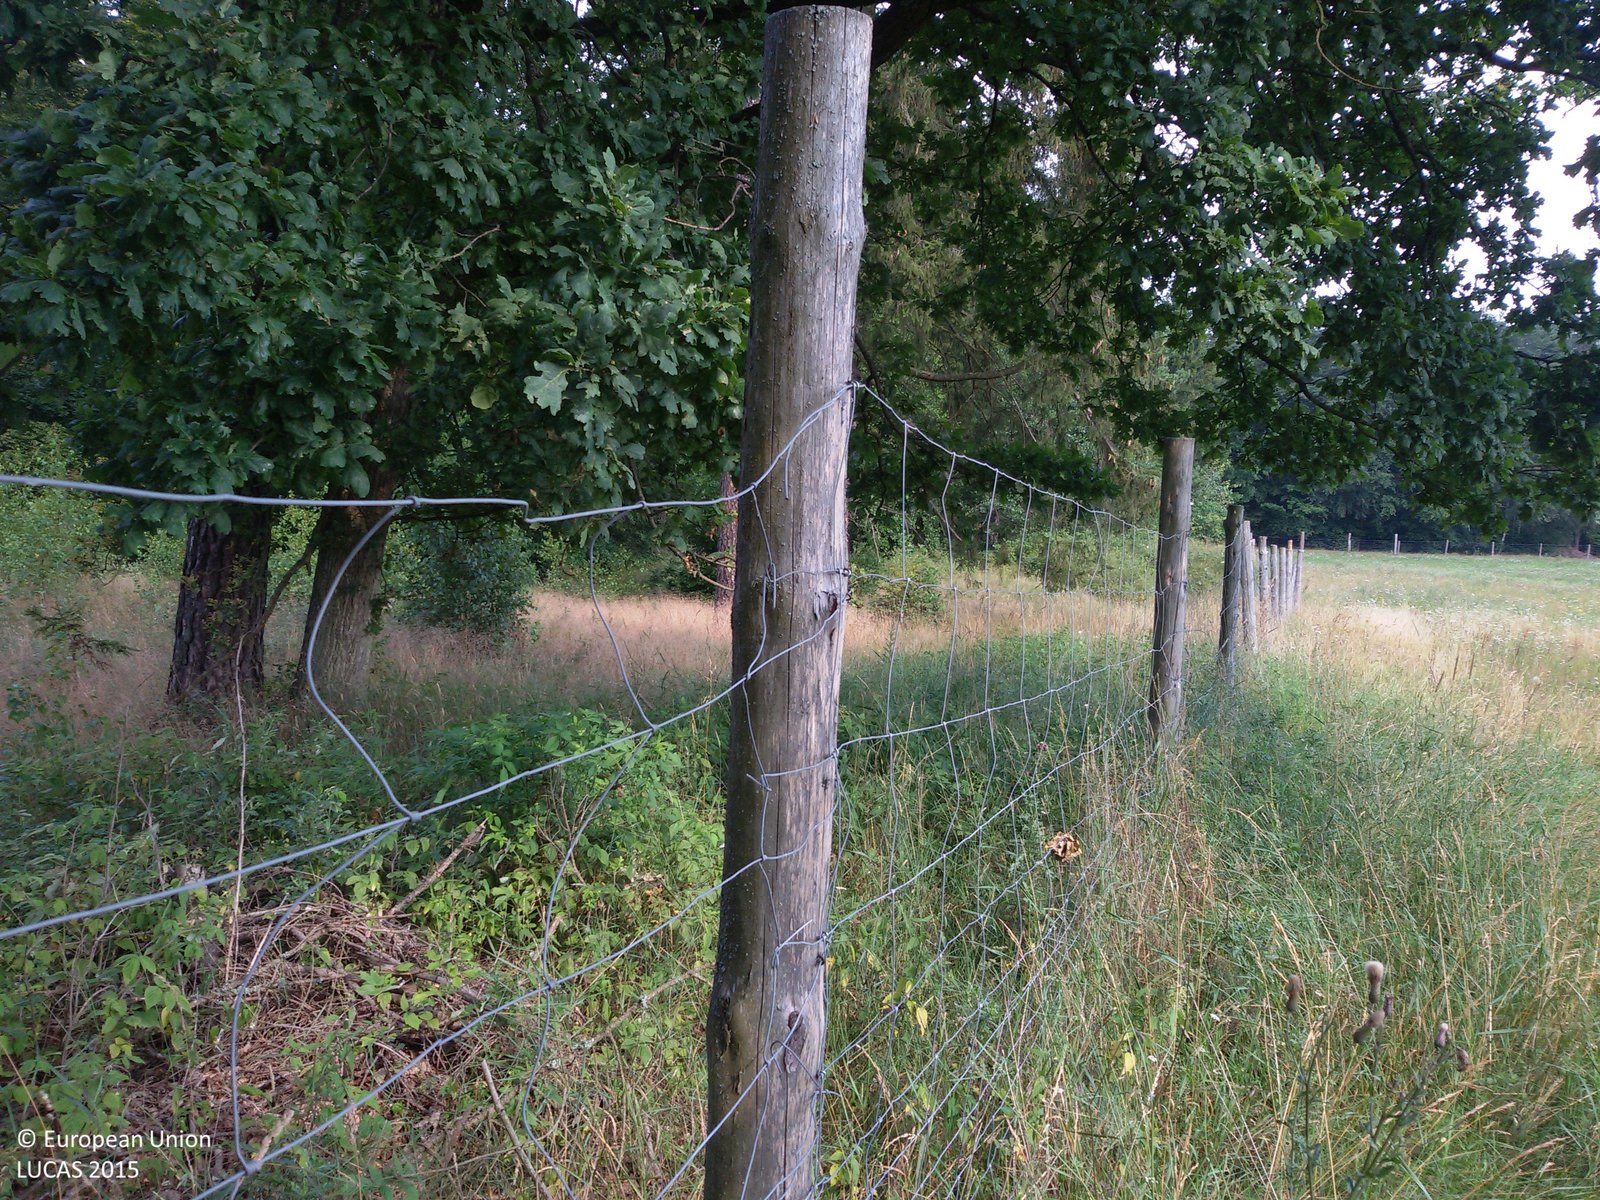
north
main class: Woodland
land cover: Pine dominated mixed woodland
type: hemiboreal forest and nemoral coniferous forest and mixed broadleaved-coniferous forest
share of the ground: > 75 %
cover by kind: coniferous forest trees 60 %, broadleaved forest trees 25 %, herbaceous plants 10 %, shrubs 5 %
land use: Forestry
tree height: > 5 m
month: August
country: PL
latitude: 54.2502
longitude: 17.2383
